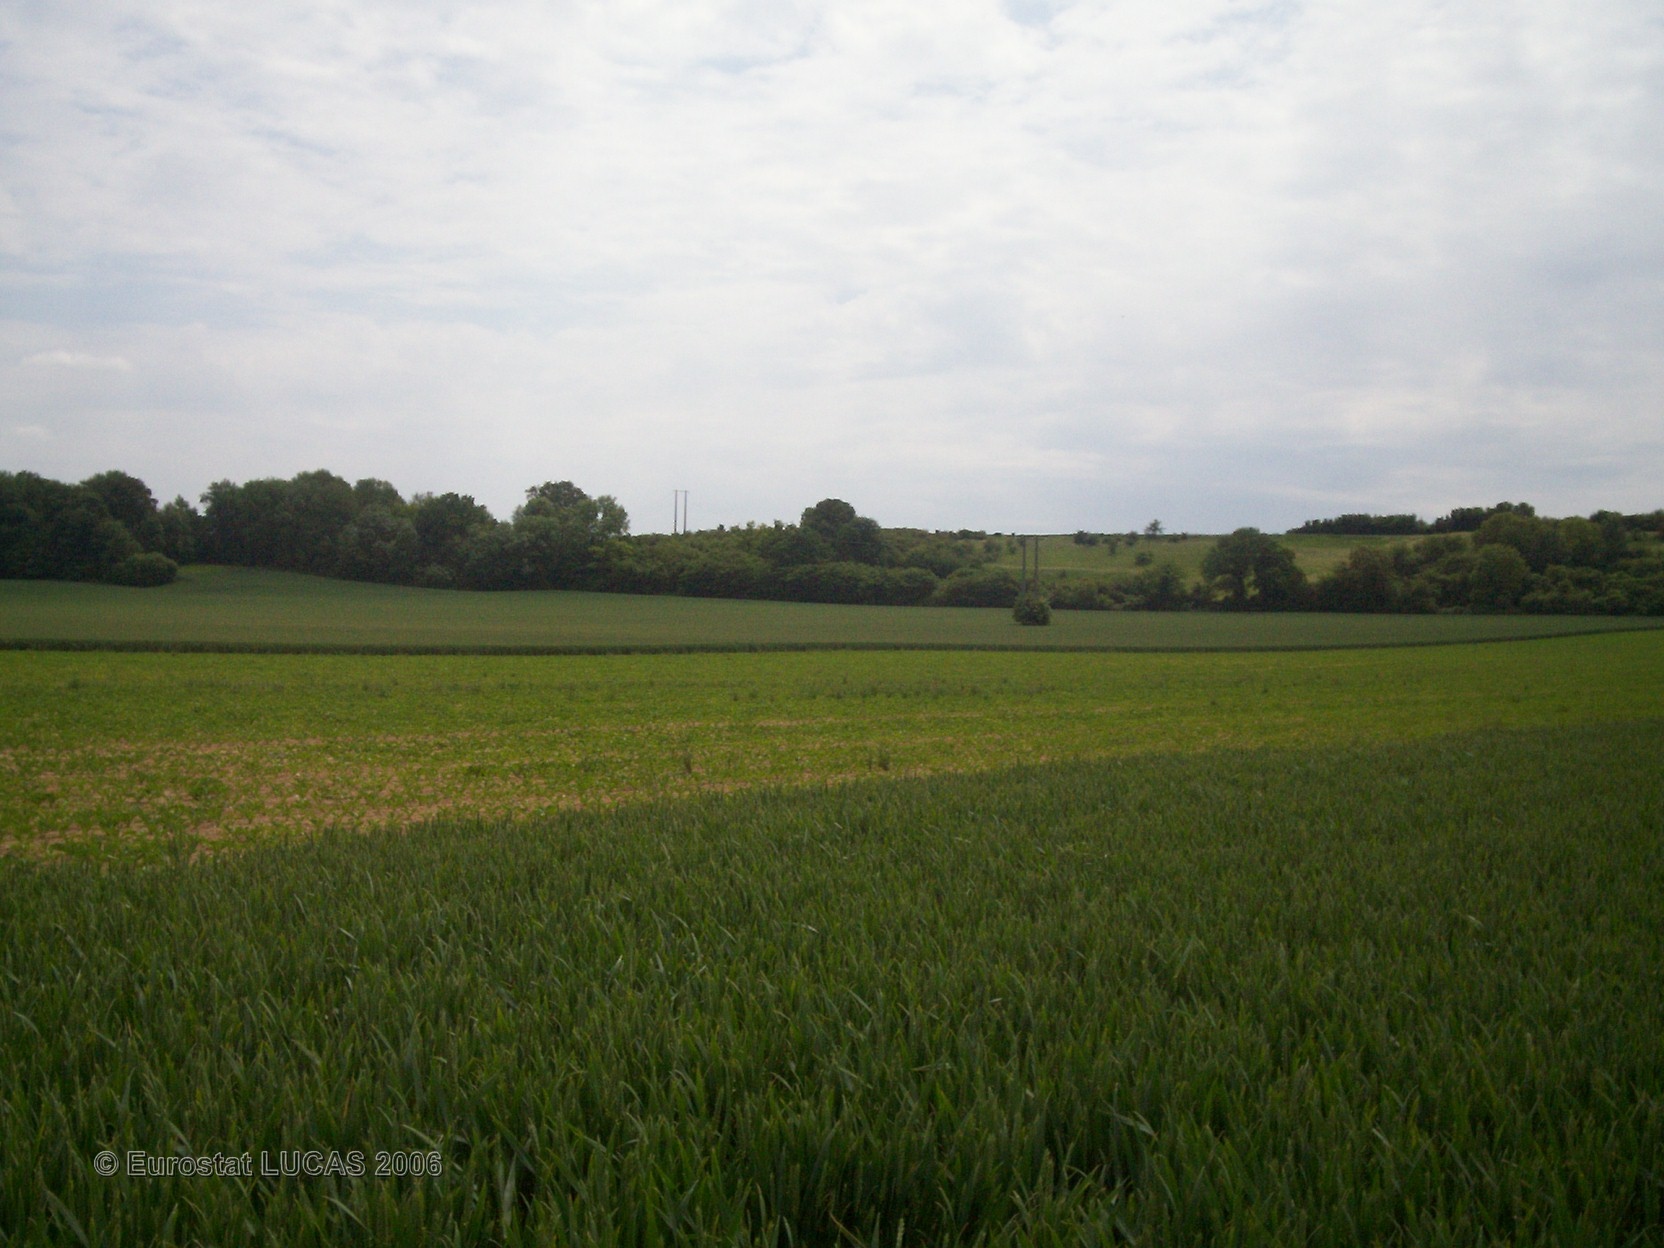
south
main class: Cropland
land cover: Common wheat
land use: Agriculture (excluding fallow land and kitchen gardens)
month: June
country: FR
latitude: 49.6926
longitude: 2.6275
